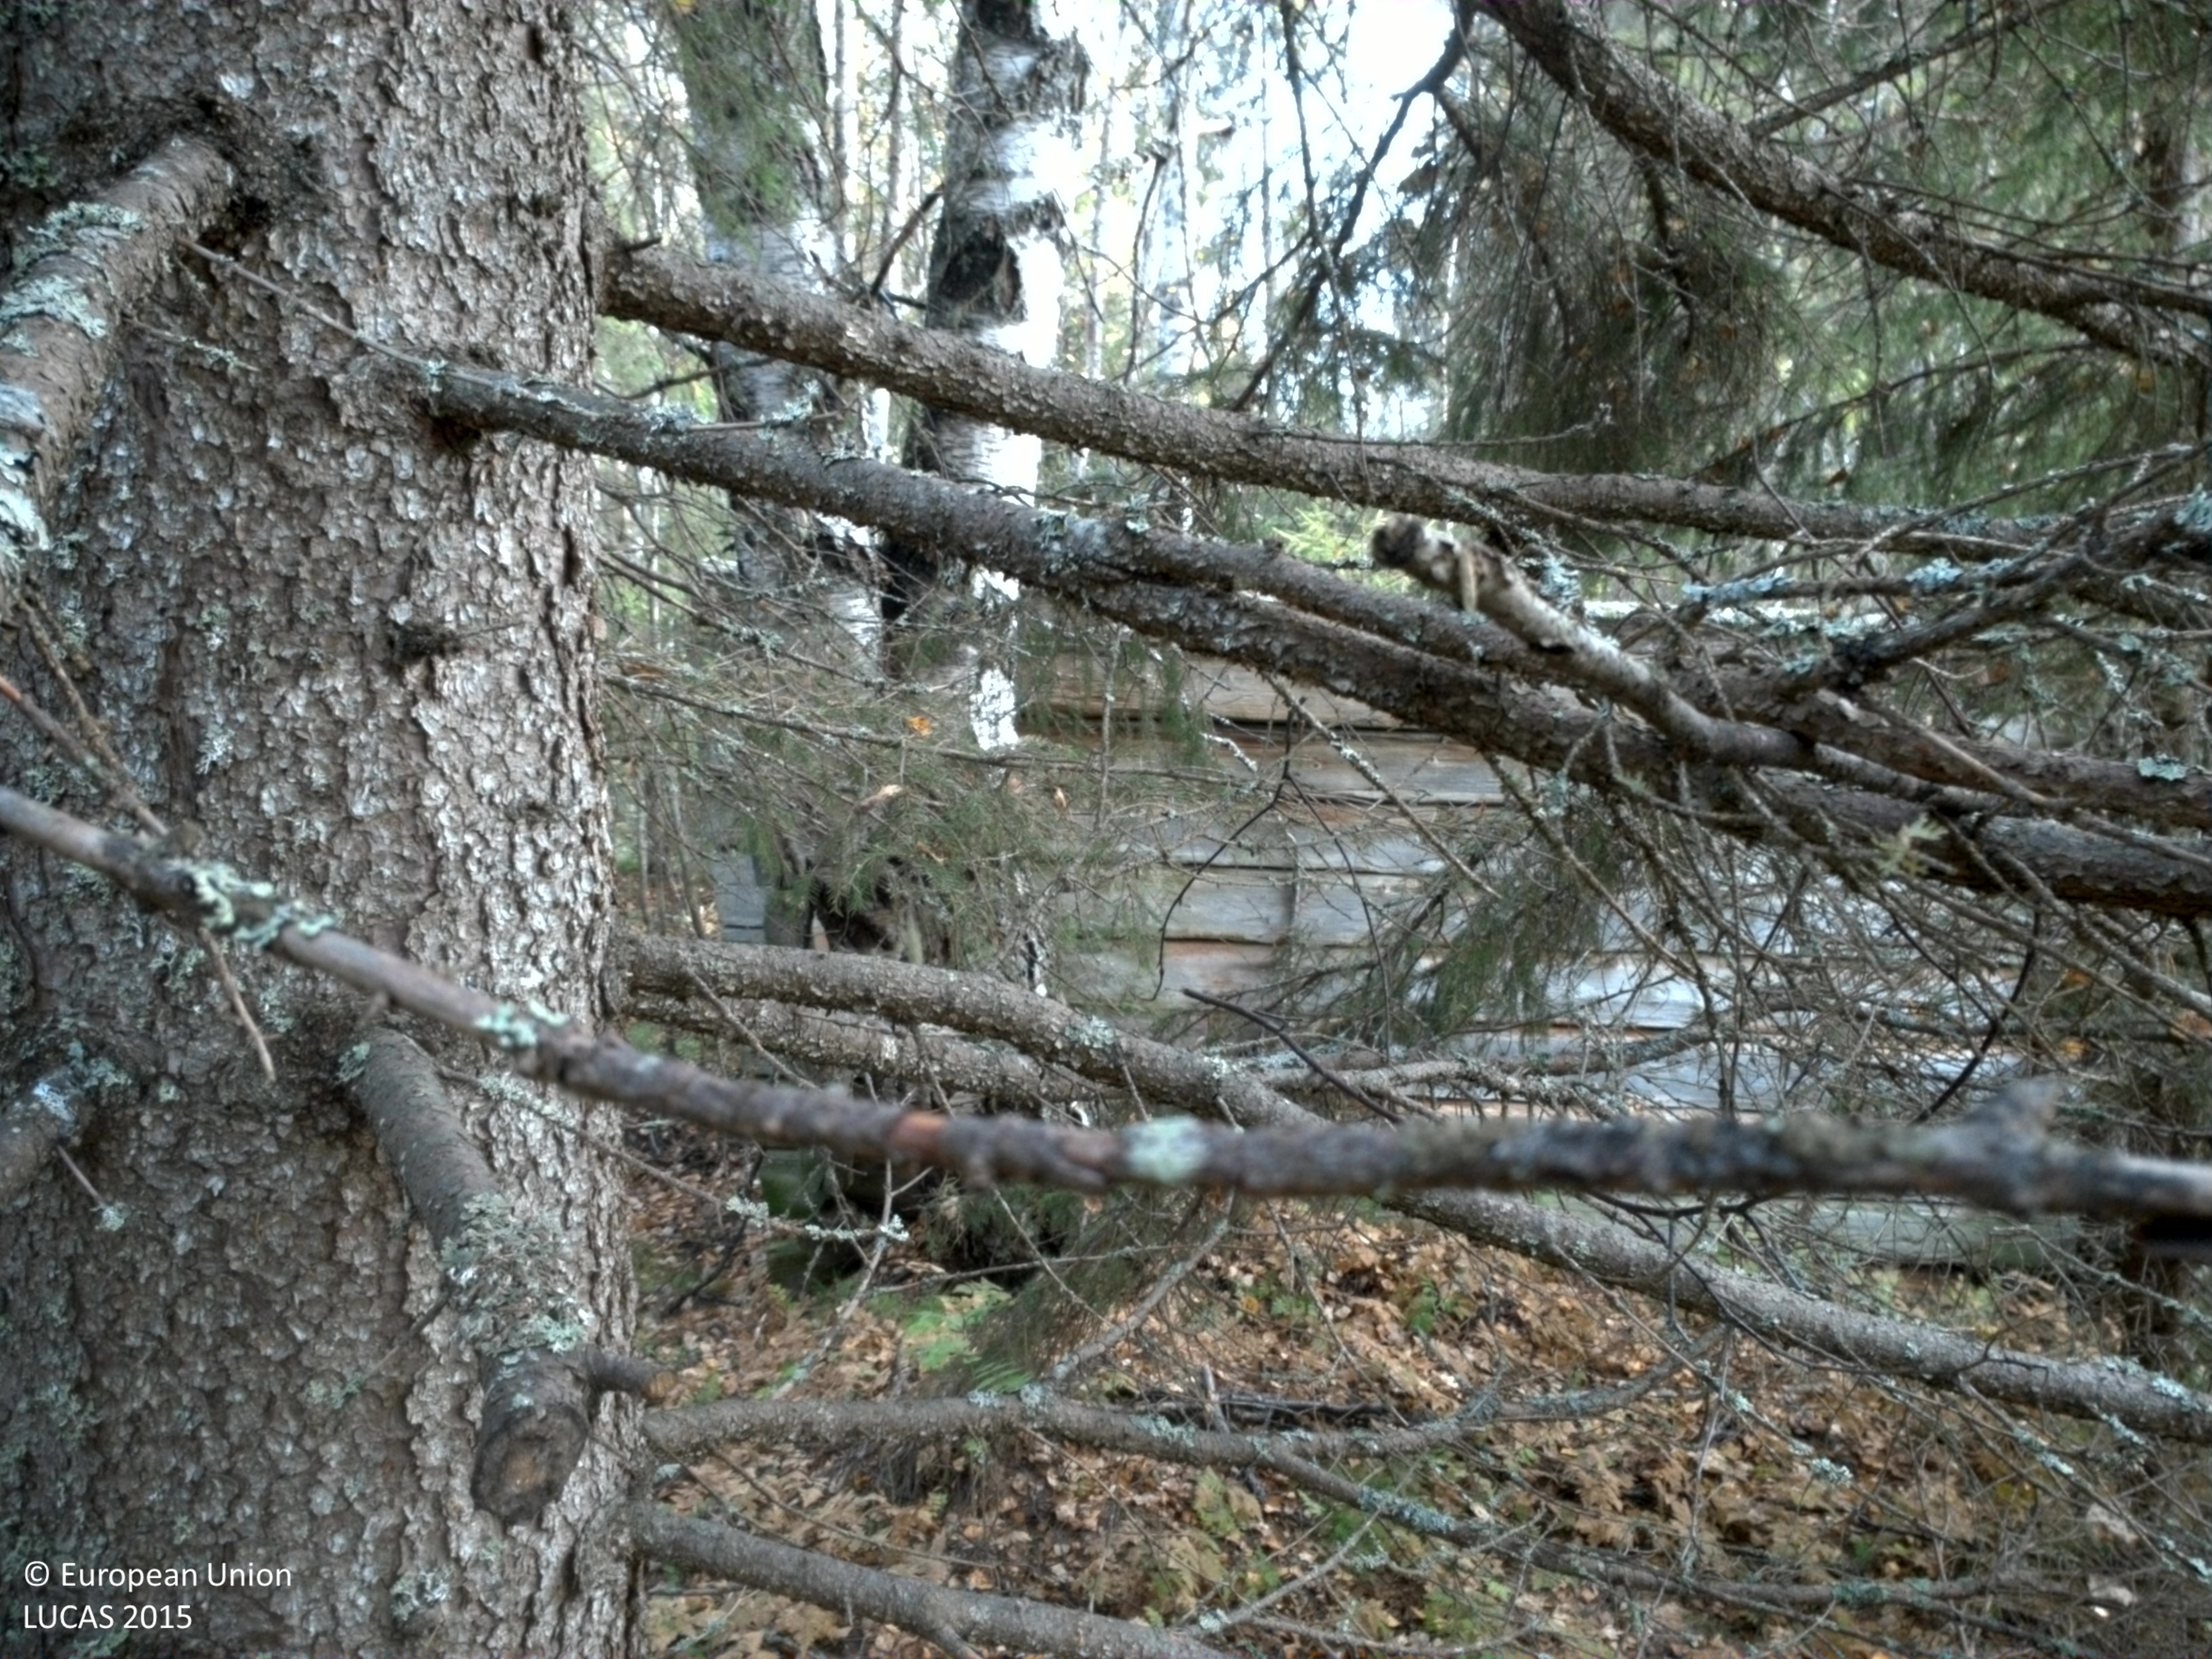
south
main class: Woodland
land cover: Spruce dominated mixed woodland
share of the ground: 50 - 75 %
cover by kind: coniferous forest trees 35 %, broadleaved forest trees 25 %, shrubs 20 %, herbaceous plants 15 %, unconsolidated bare surface 5 %
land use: Forestry
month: September
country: SE
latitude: 65.7281
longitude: 22.1210
